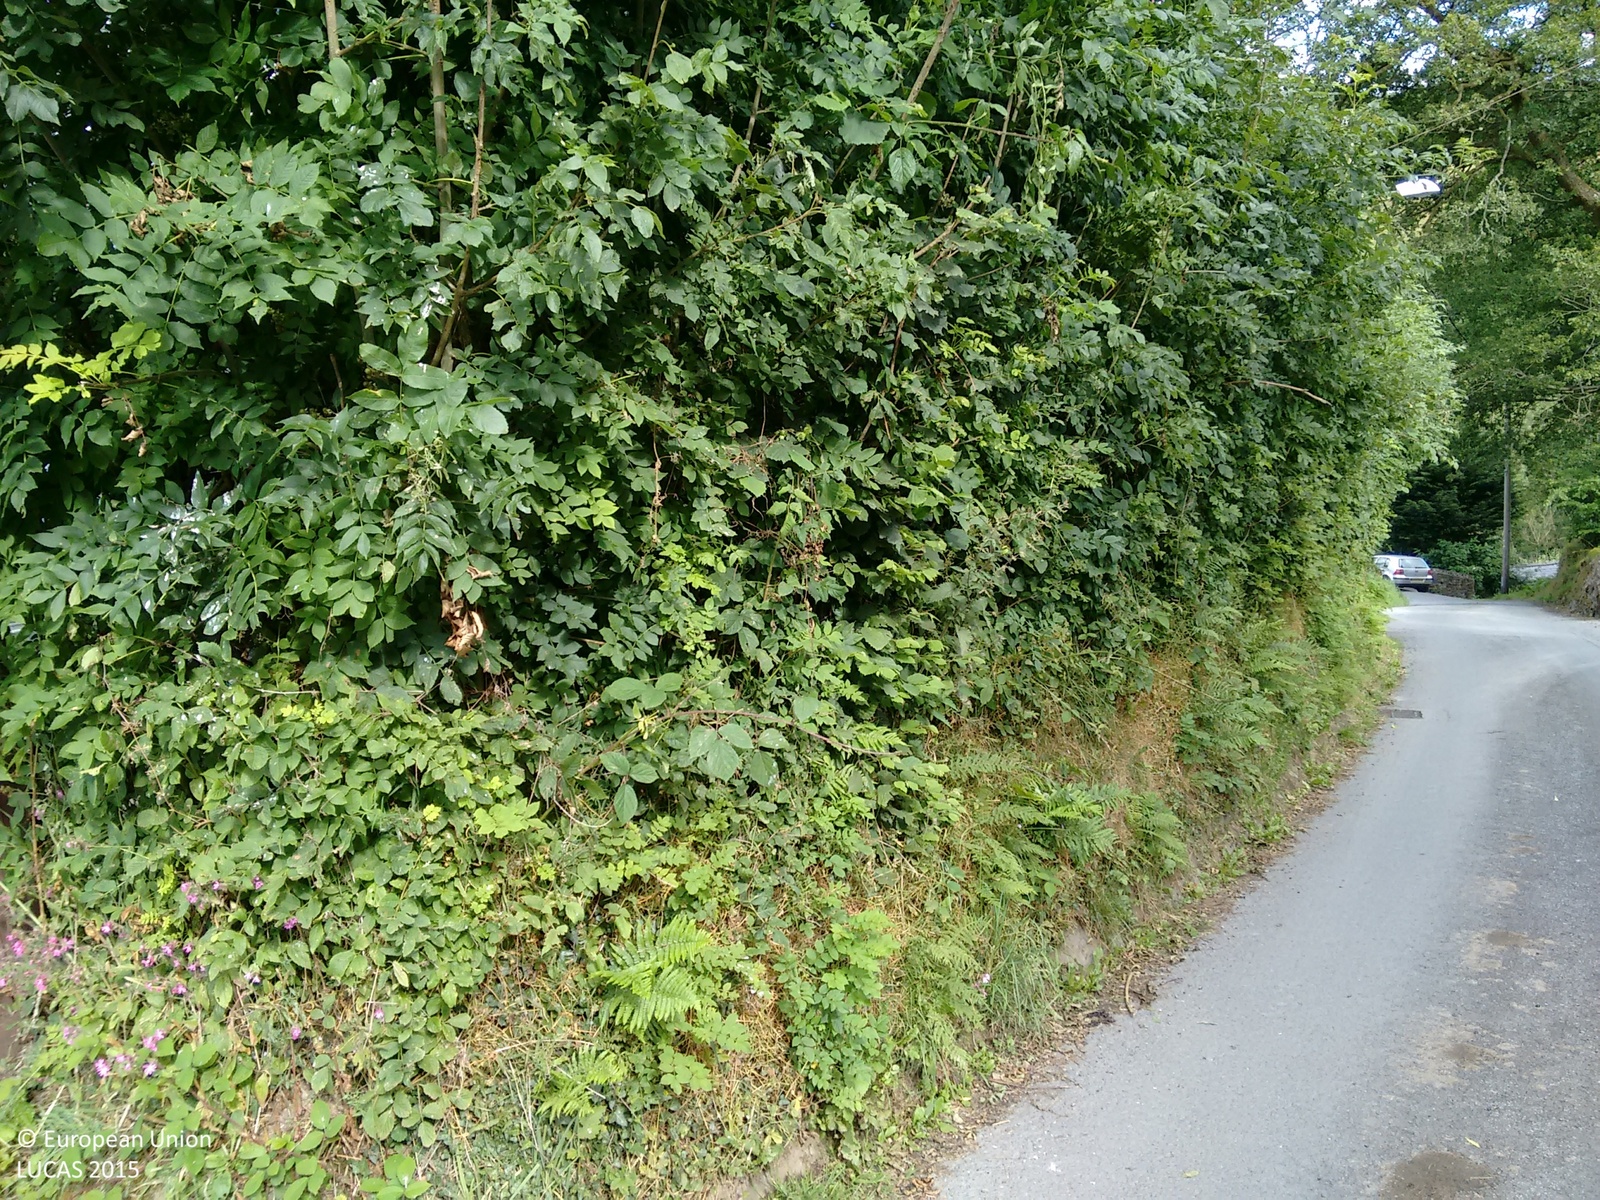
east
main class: Grassland
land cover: Grassland with sparse tree/shrub cover
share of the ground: > 75 %
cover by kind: herbaceous plants 95 %, broadleaved forest trees 5 %
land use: Residential
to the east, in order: Grassland with sparse tree/shrub cover; Broadleaved woodland; Rivers and streams; Broadleaved woodland; Fences; Managed hedges; Paved roads, cycling and walking lanes; Artificial constructions in urban areas; Grassland without tree/shrub cover; Fences; Managed hedges; Paved roads, cycling and walking lanes; Managed hedges; Fences; Grassland without tree/shrub cover; Fences; Managed hedges; Paved roads, cycling and walking lanes; Managed hedges; Fences; Electric lines; Grassland without tree/shrub cover
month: August
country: GB
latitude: 52.0584
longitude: -4.2621
